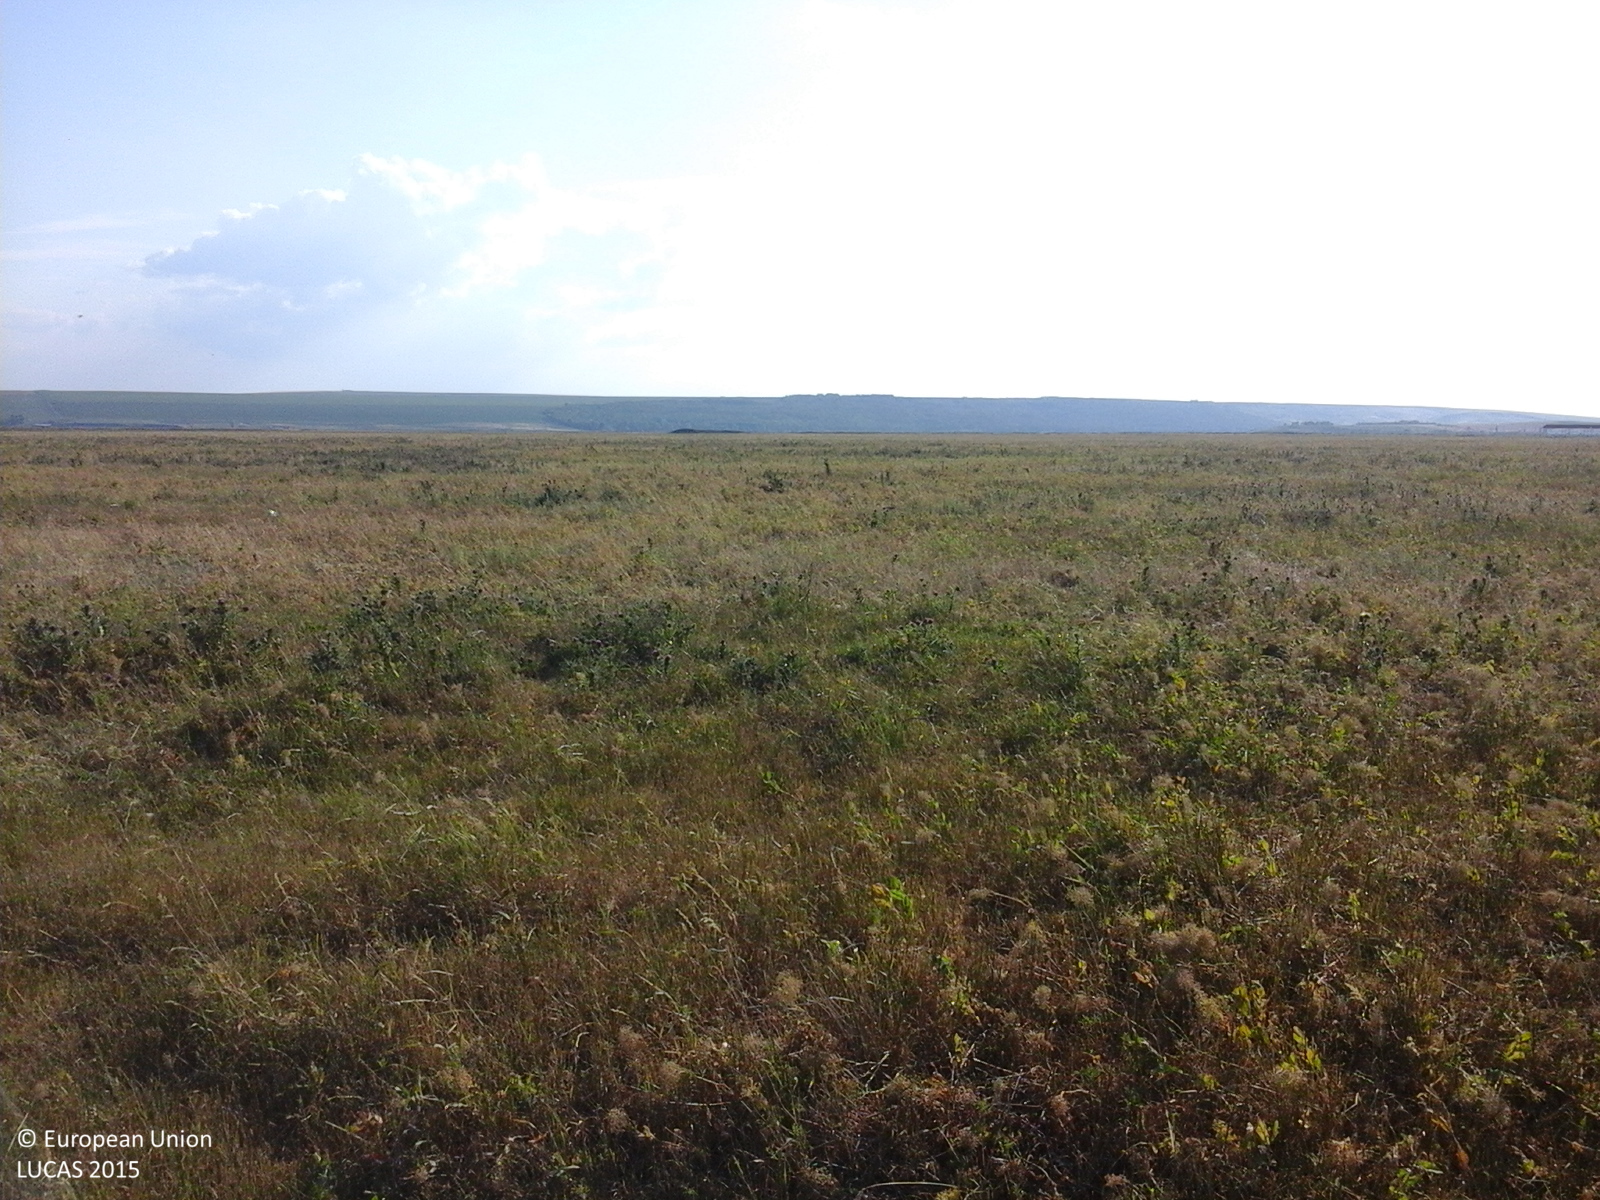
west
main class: Grassland
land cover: Grassland without tree/shrub cover
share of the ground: > 75 %
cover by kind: herbaceous plants 100 %
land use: Agriculture (excluding fallow land and kitchen gardens)
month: June
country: RO
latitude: 47.4036
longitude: 27.3526
